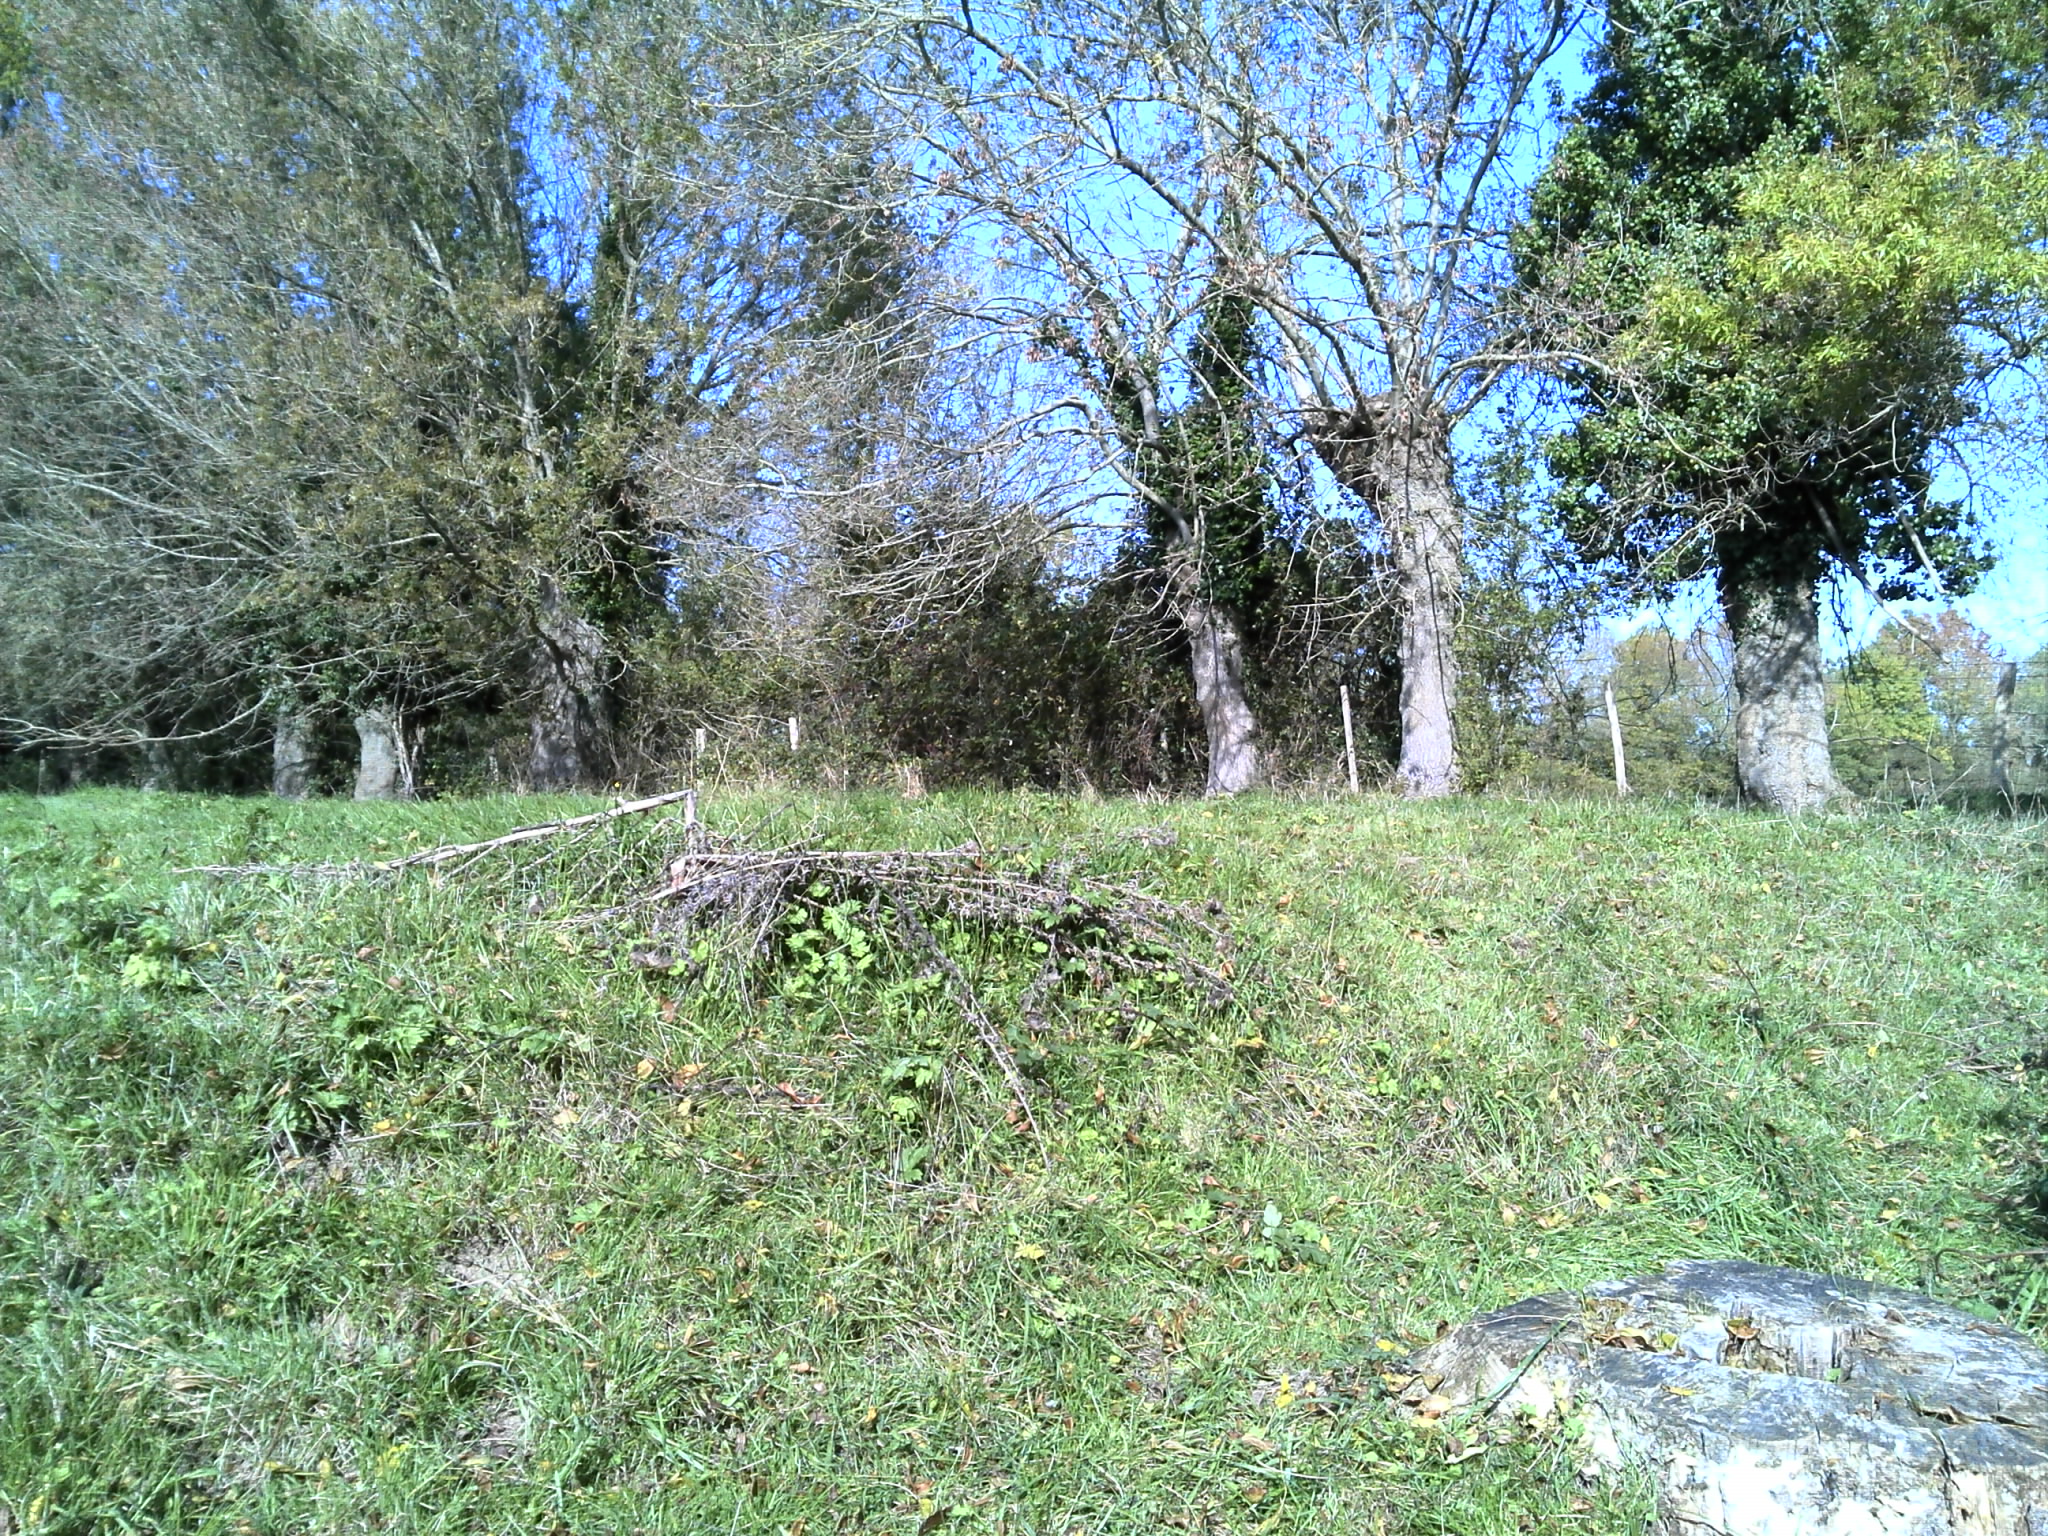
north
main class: Grassland
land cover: Grassland without tree/shrub cover
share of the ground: > 75 %
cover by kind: herbaceous plants 100 %
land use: Agriculture (excluding fallow land and kitchen gardens)
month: October
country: FR
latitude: 47.3315
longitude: -1.3008
